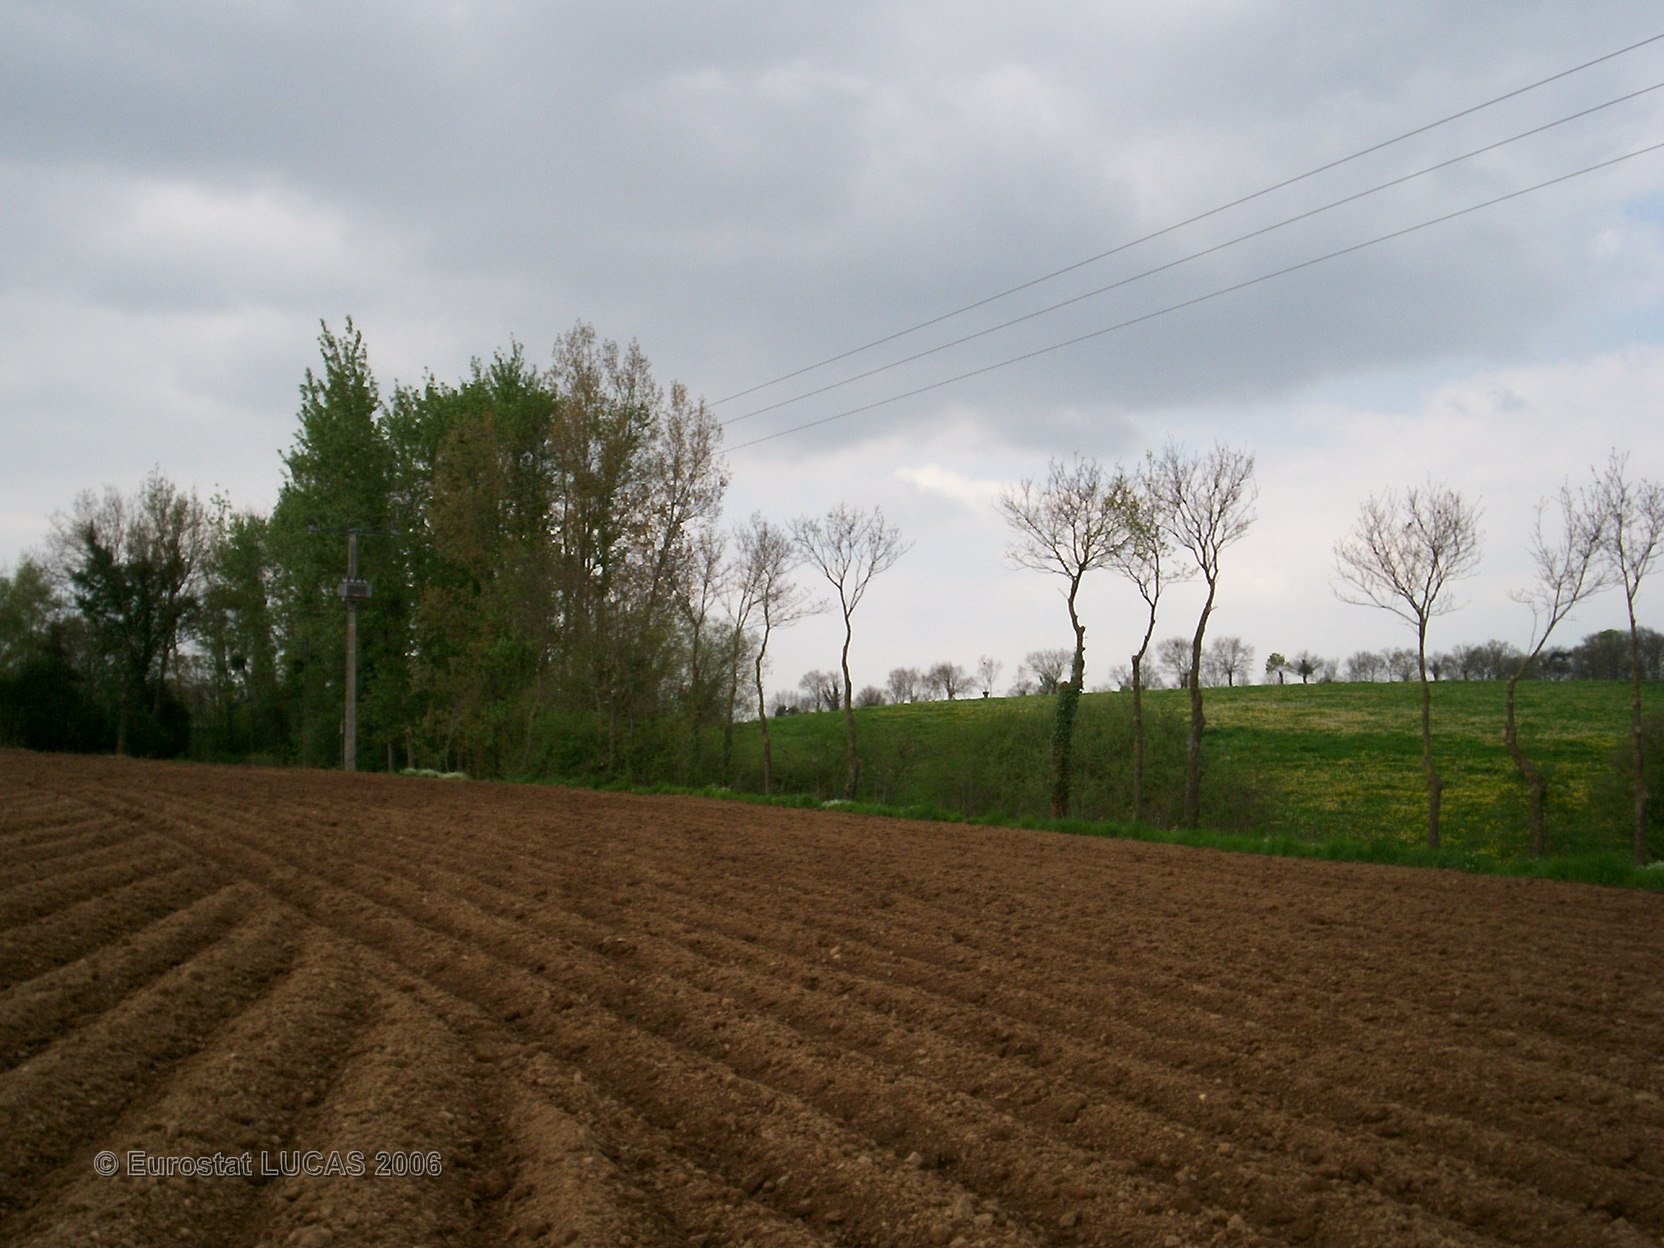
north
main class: Cropland
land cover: Maize
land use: Agriculture (excluding fallow land and kitchen gardens)
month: April
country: FR
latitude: 48.0112
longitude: -2.4046
